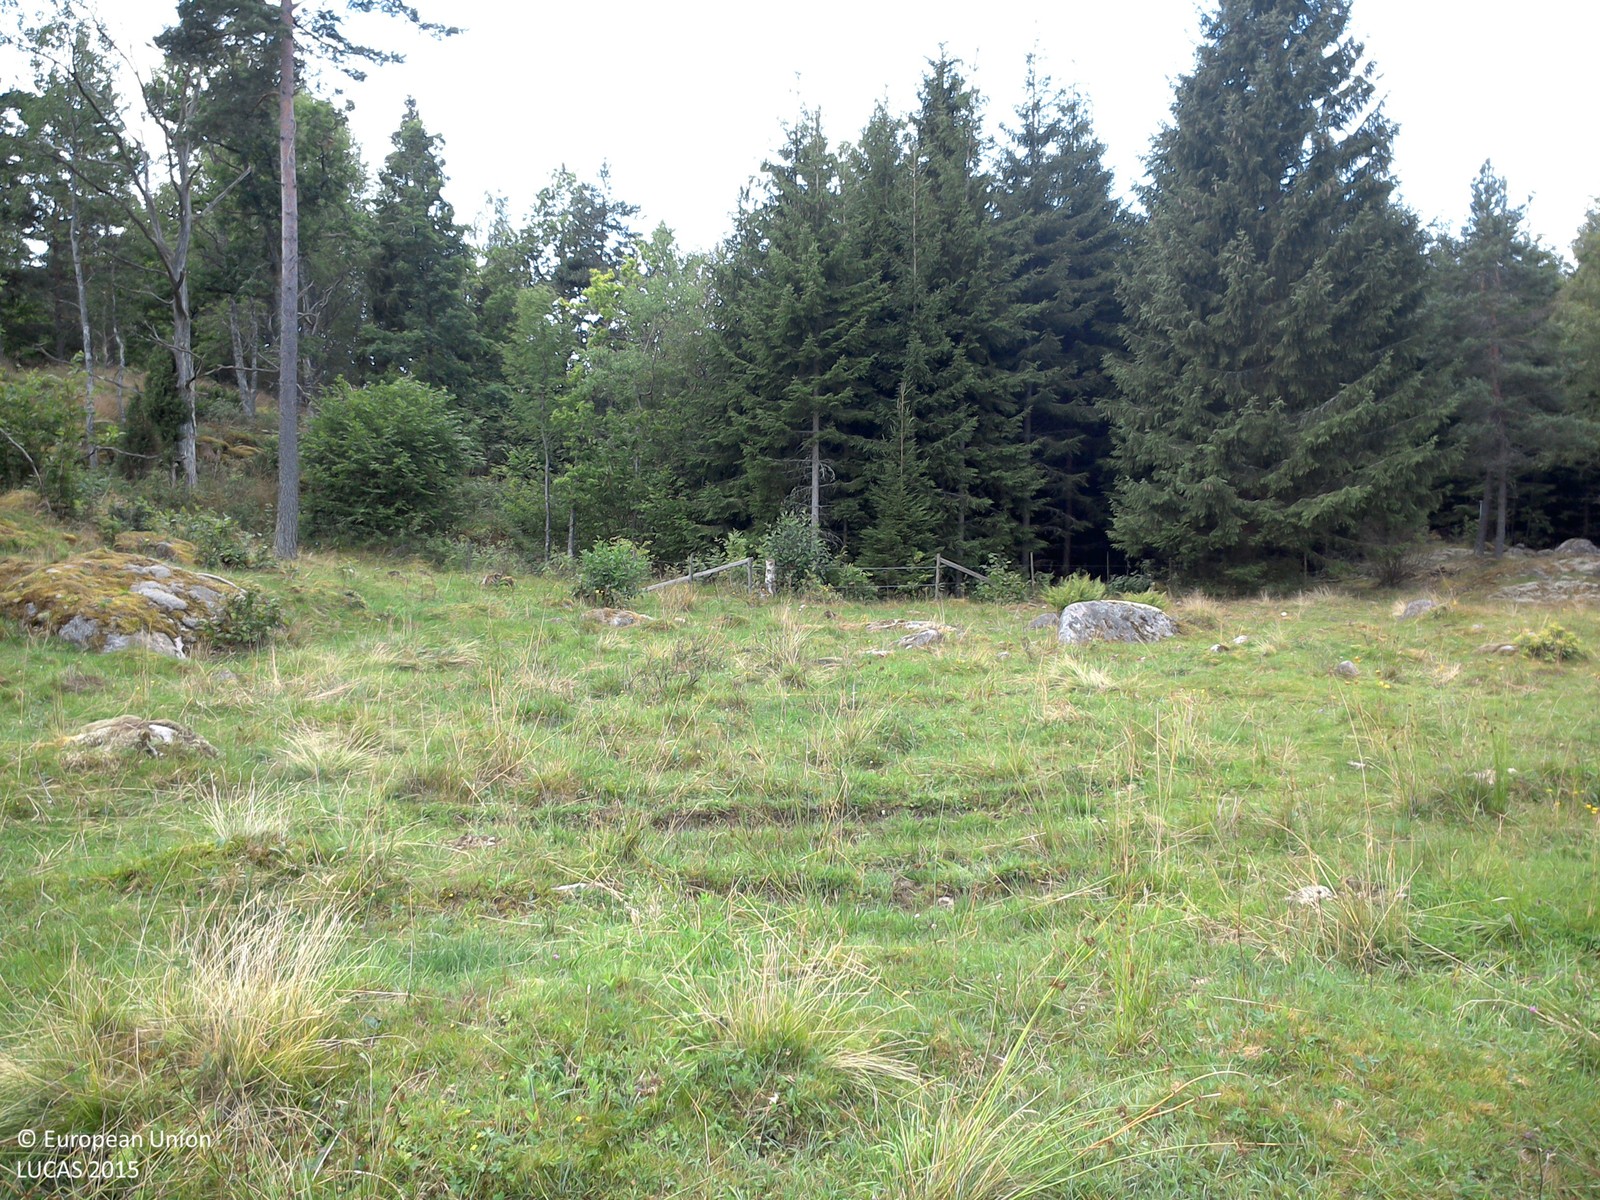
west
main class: Grassland
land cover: Grassland without tree/shrub cover
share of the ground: > 75 %
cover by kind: herbaceous plants 100 %
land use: Agriculture (excluding fallow land and kitchen gardens)
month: August
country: SE
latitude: 58.1900
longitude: 14.7400
